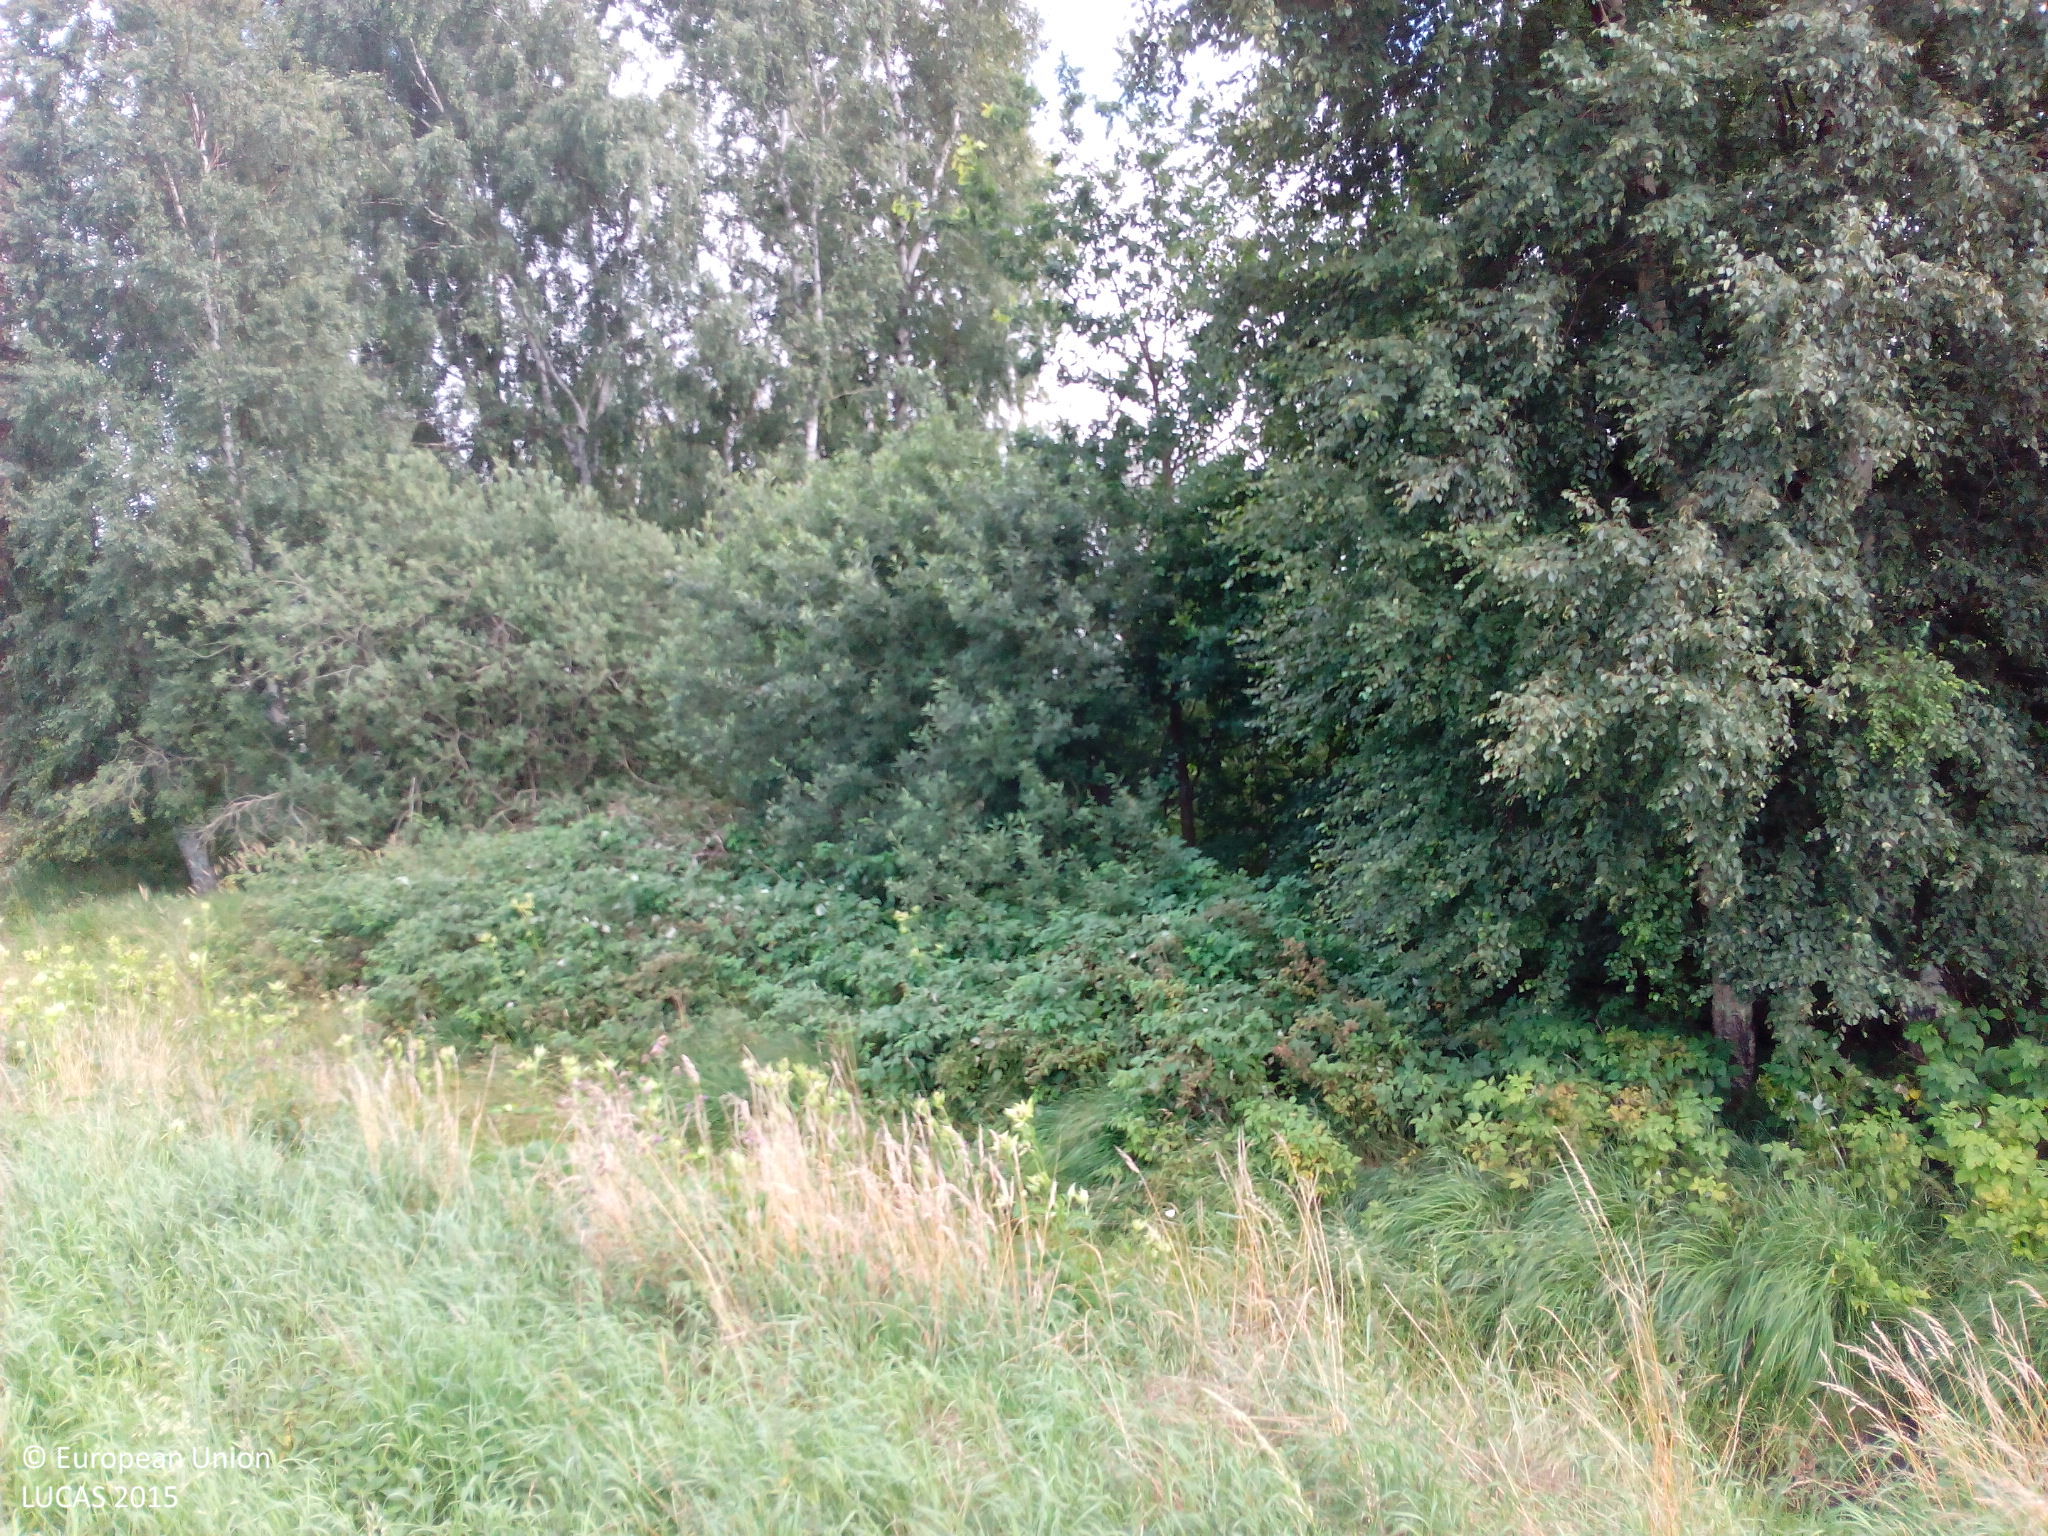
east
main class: Cropland
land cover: Maize
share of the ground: > 75 %
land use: Agriculture (excluding fallow land and kitchen gardens)
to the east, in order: Maize; Grass margins; Tracks; Grassland without tree/shrub cover; Ditches and canals; Grassland without tree/shrub cover
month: August
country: DE
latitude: 53.4726
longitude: 13.6609
